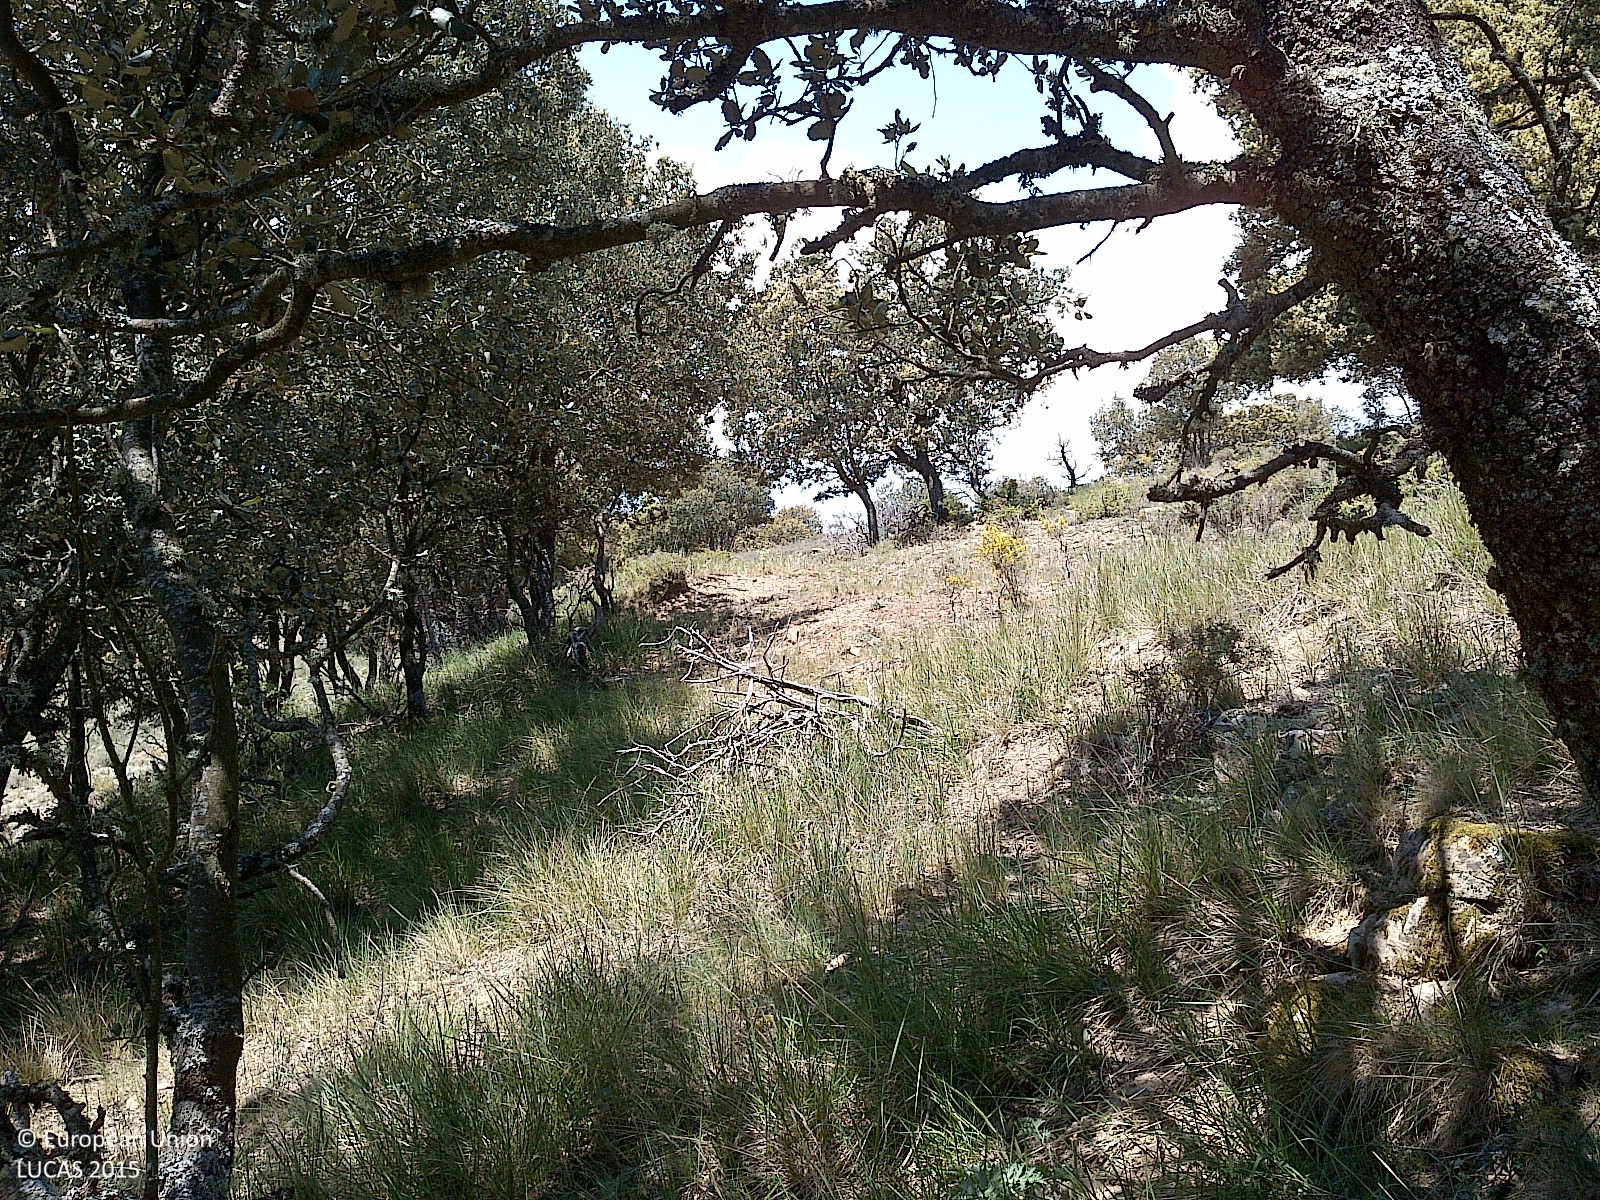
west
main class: Woodland
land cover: Broadleaved woodland
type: broadleaved evergreen forest
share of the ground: 25 - 50 %
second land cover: Grassland without tree/shrub cover
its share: 50 - 75 %
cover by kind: broadleaved forest trees 45 %, herbaceous plants 35 %, consolidated bare surface 15 %, shrubs 5 %
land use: Forestry
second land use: Agriculture (excluding fallow land and kitchen gardens)
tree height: < 5 m
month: May
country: ES
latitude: 41.8571
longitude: -2.2145
